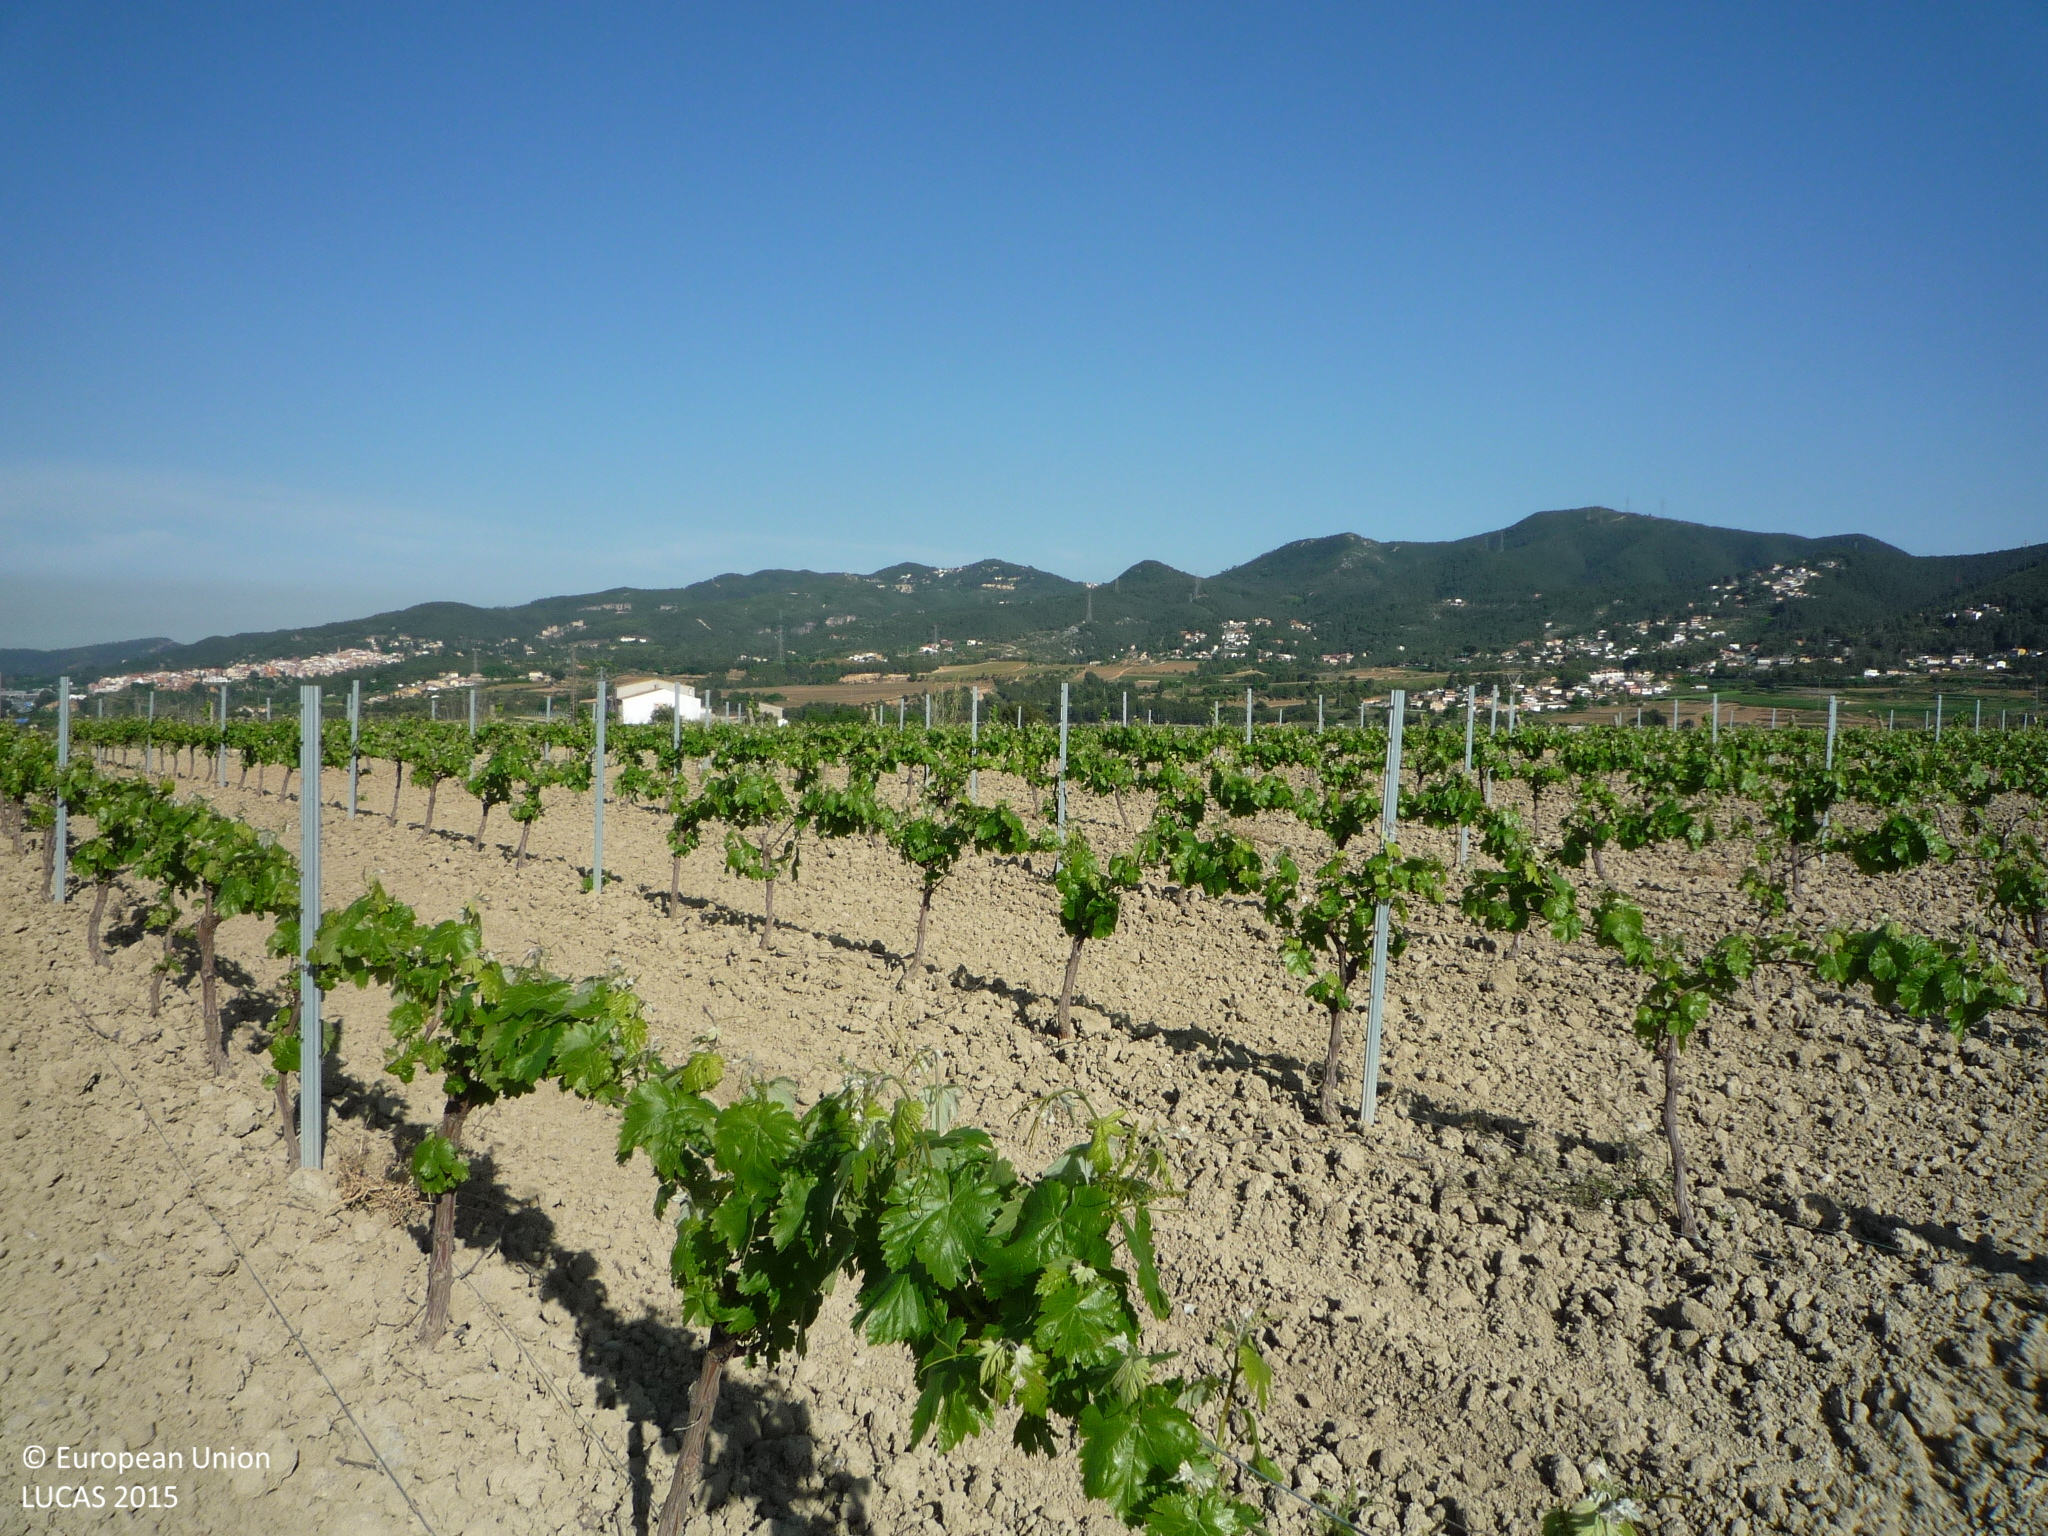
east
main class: Cropland
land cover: Vineyards
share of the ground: 10 - 25 %
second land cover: Other bare soil
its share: > 75 %
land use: Agriculture (excluding fallow land and kitchen gardens)
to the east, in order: Vineyards; Other bare soil; Tracks; Shrubland without tree cover; Vineyards; Grassland without tree/shrub cover; Tracks; Grassland without tree/shrub cover; Electric lines; Other bare soil; Vineyards
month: April
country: ES
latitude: 41.4333
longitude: 1.8196
